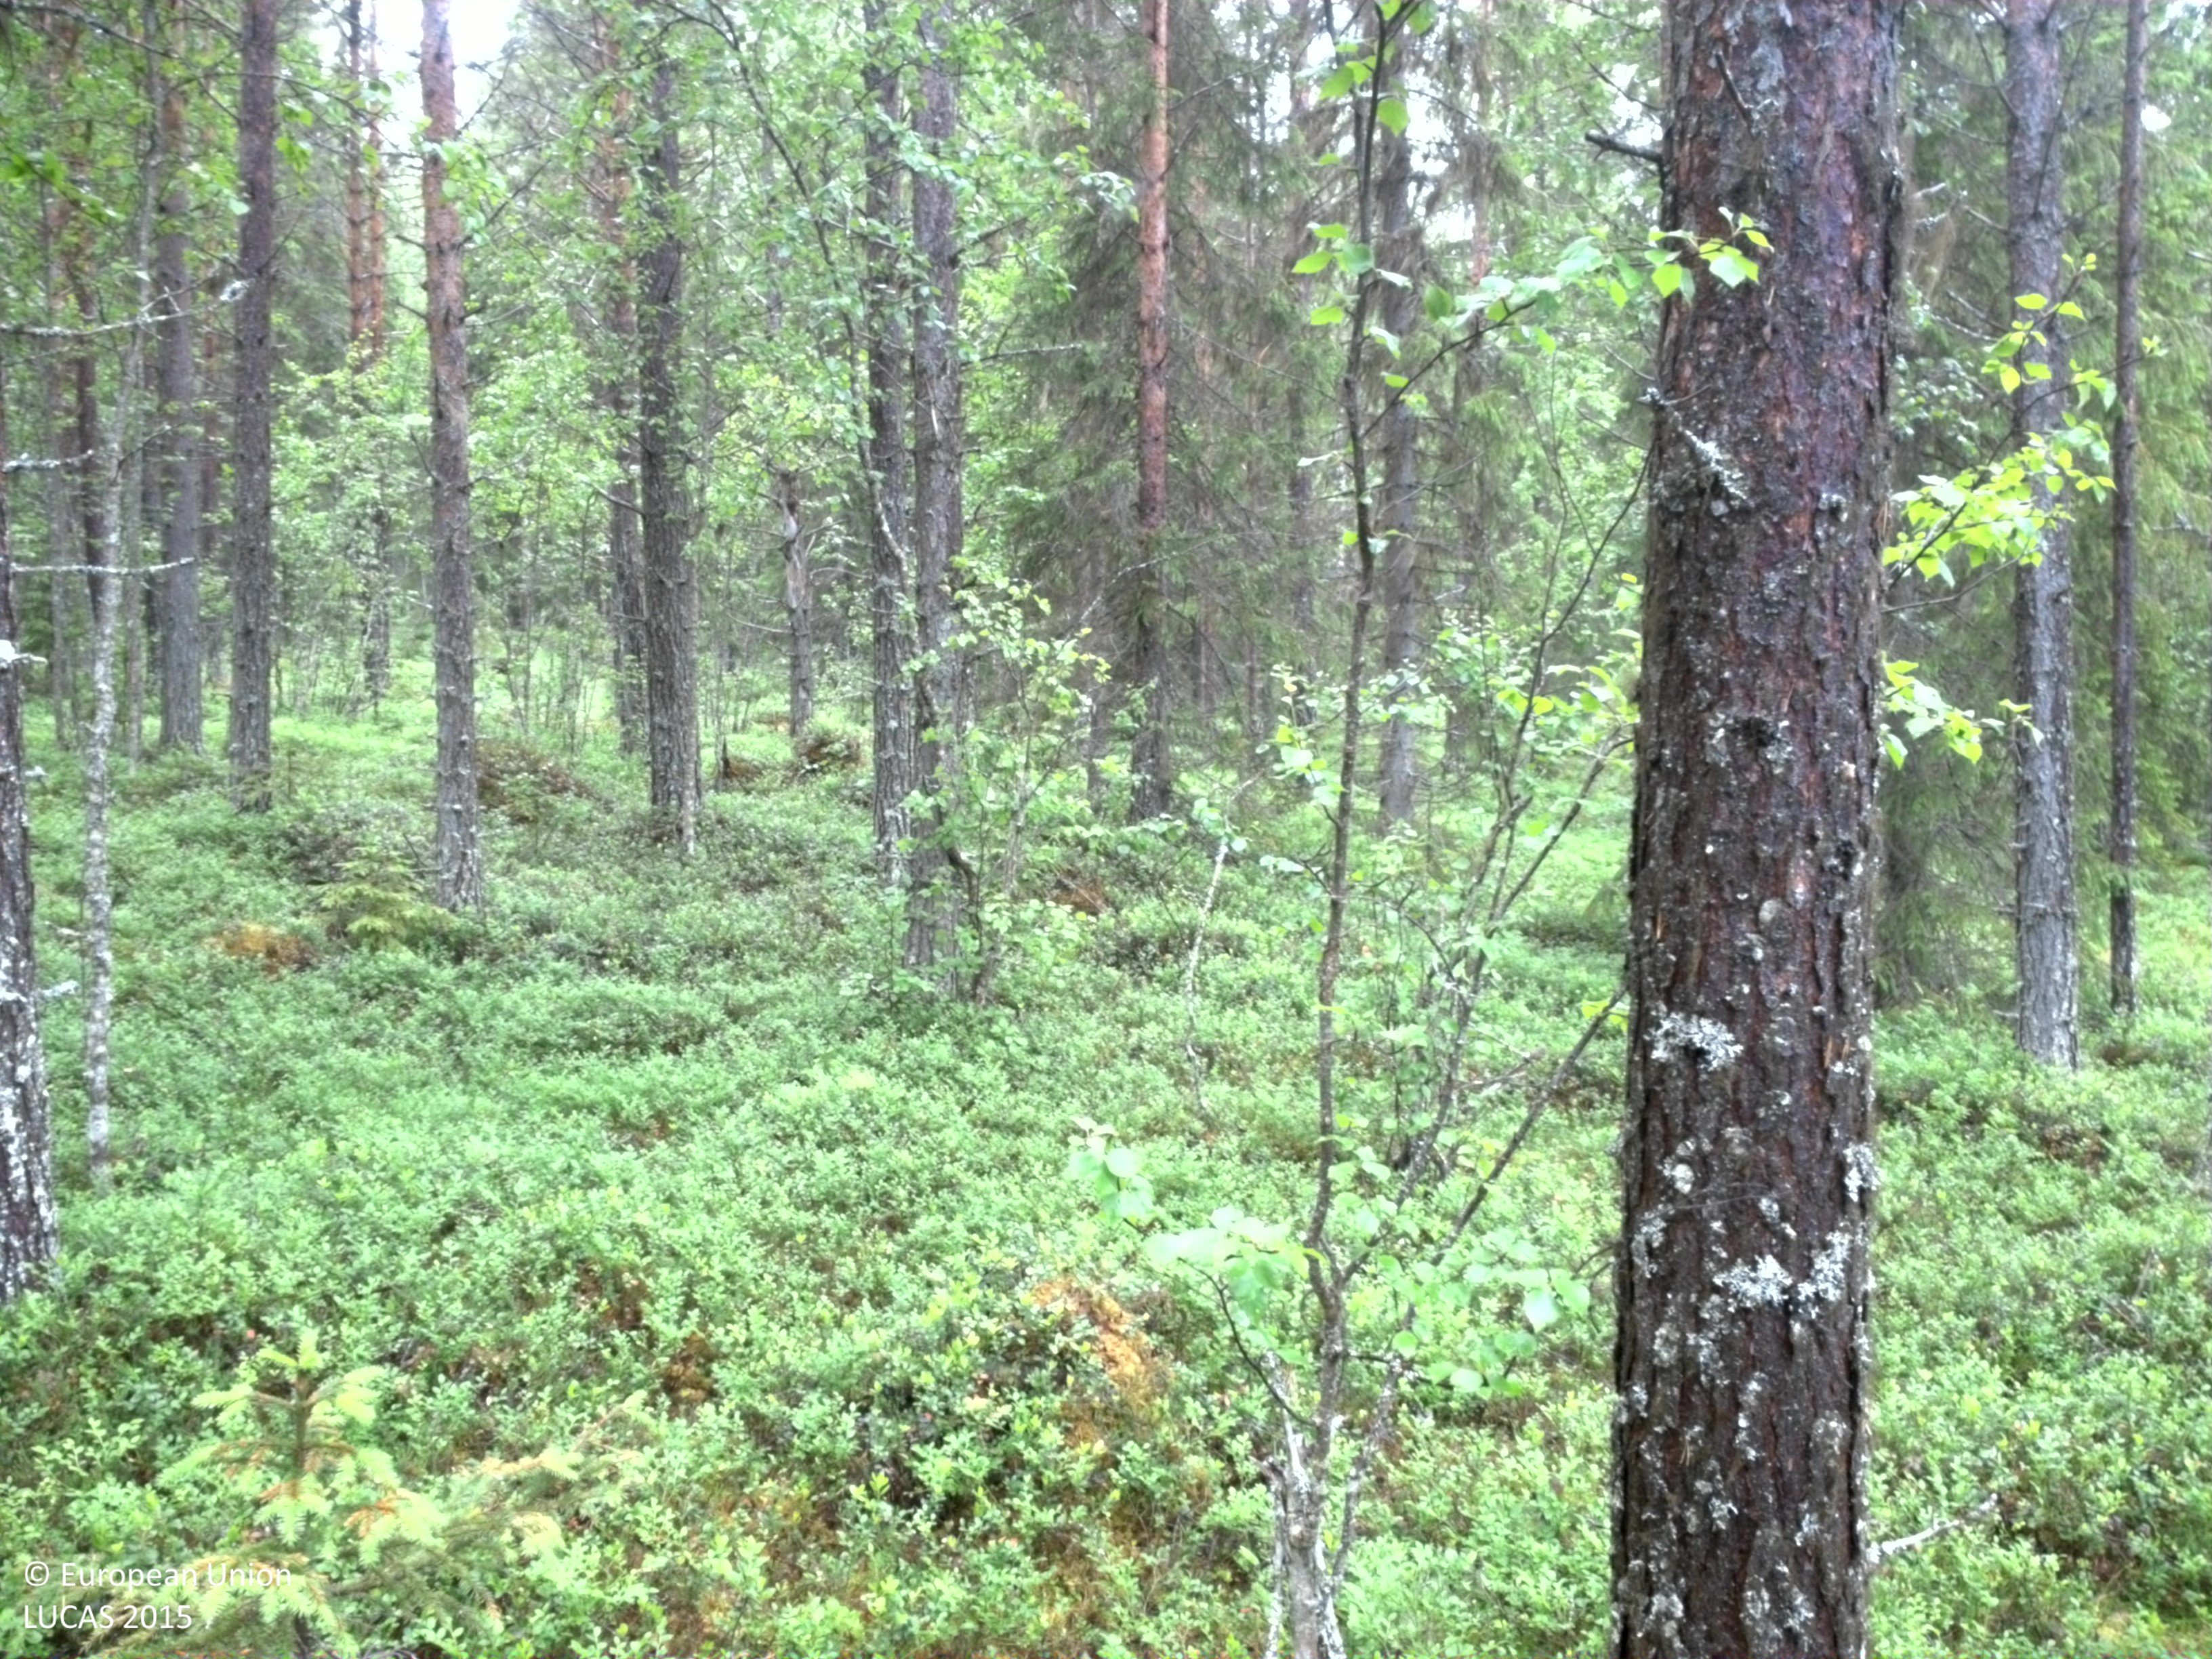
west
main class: Woodland
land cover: Pine dominated coniferous woodland
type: boreal forest
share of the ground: 50 - 75 %
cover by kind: coniferous forest trees 65 %, shrubs 20 %, broadleaved forest trees 10 %, lichens and mosses 5 %
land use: Forestry
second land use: Amenities, museums, leisure
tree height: > 5 m
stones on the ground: 25 - 50 %
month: July
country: SE
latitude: 64.6365
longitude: 18.2732
